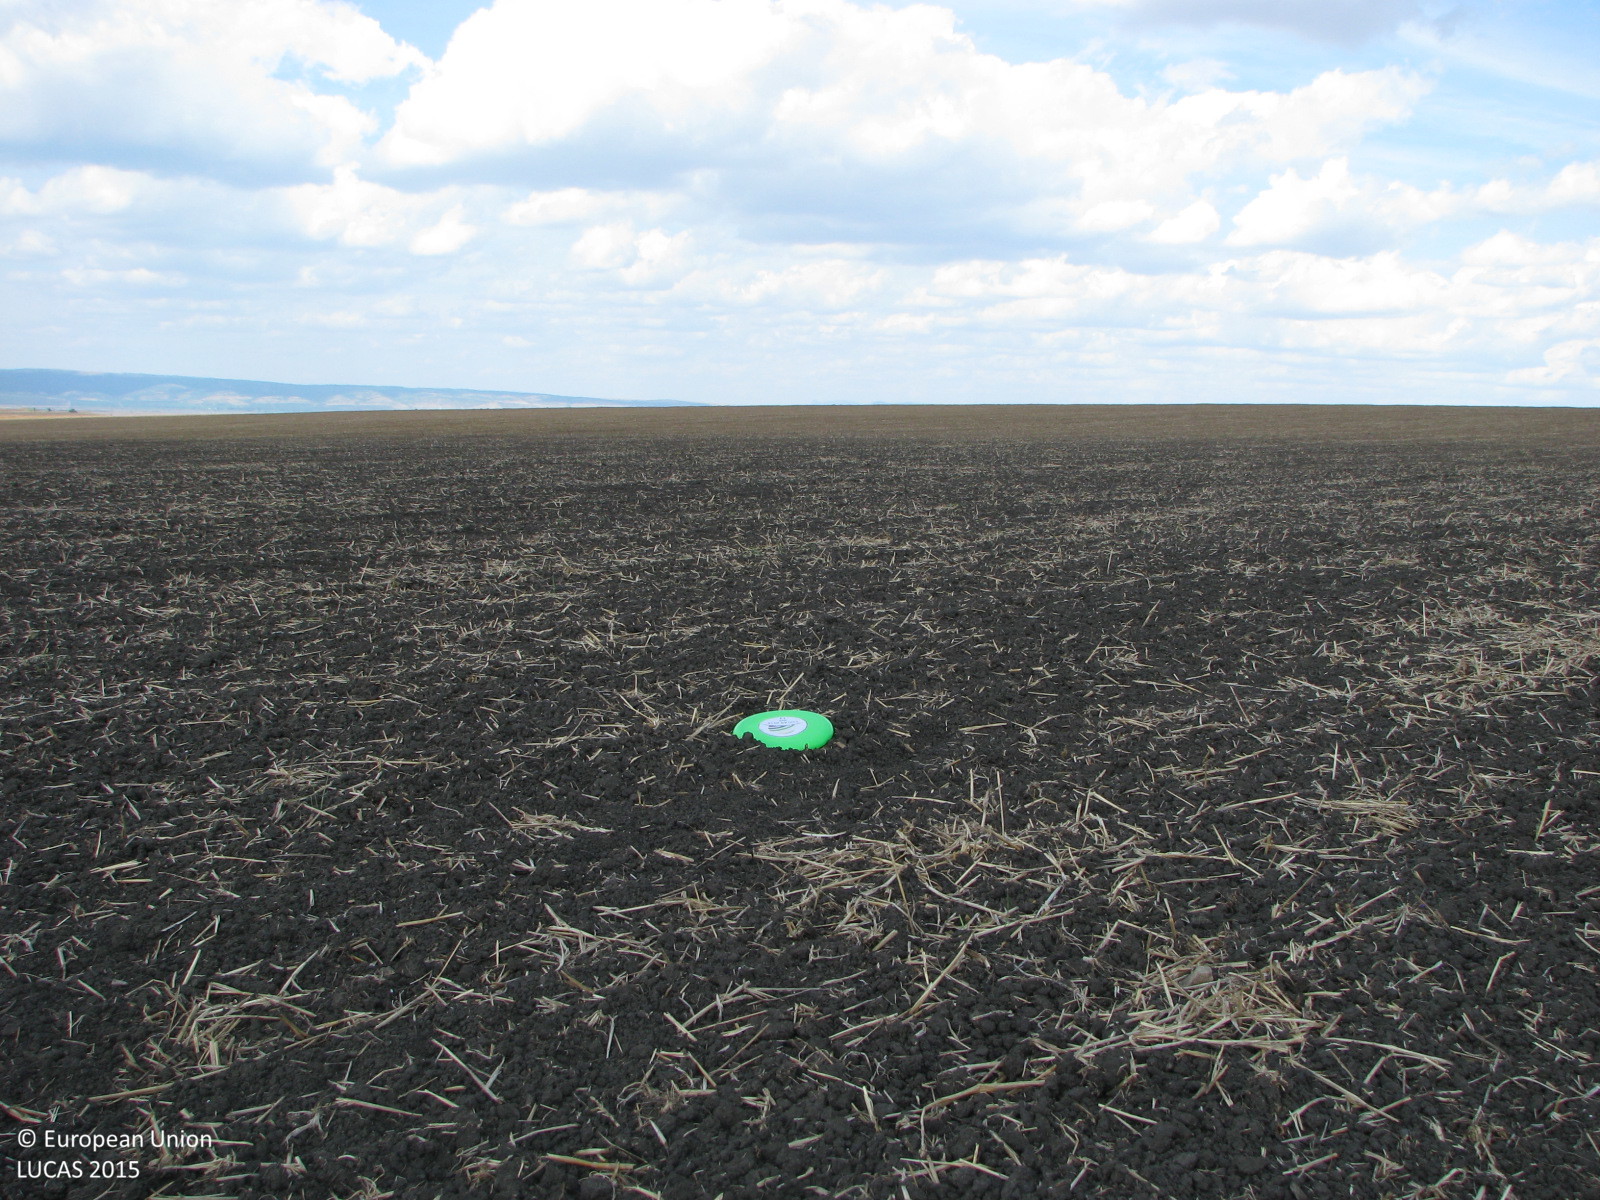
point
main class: Cropland
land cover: Common wheat
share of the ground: < 10 %
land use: Agriculture (excluding fallow land and kitchen gardens)
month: September
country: BG
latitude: 42.5329
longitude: 26.7667
